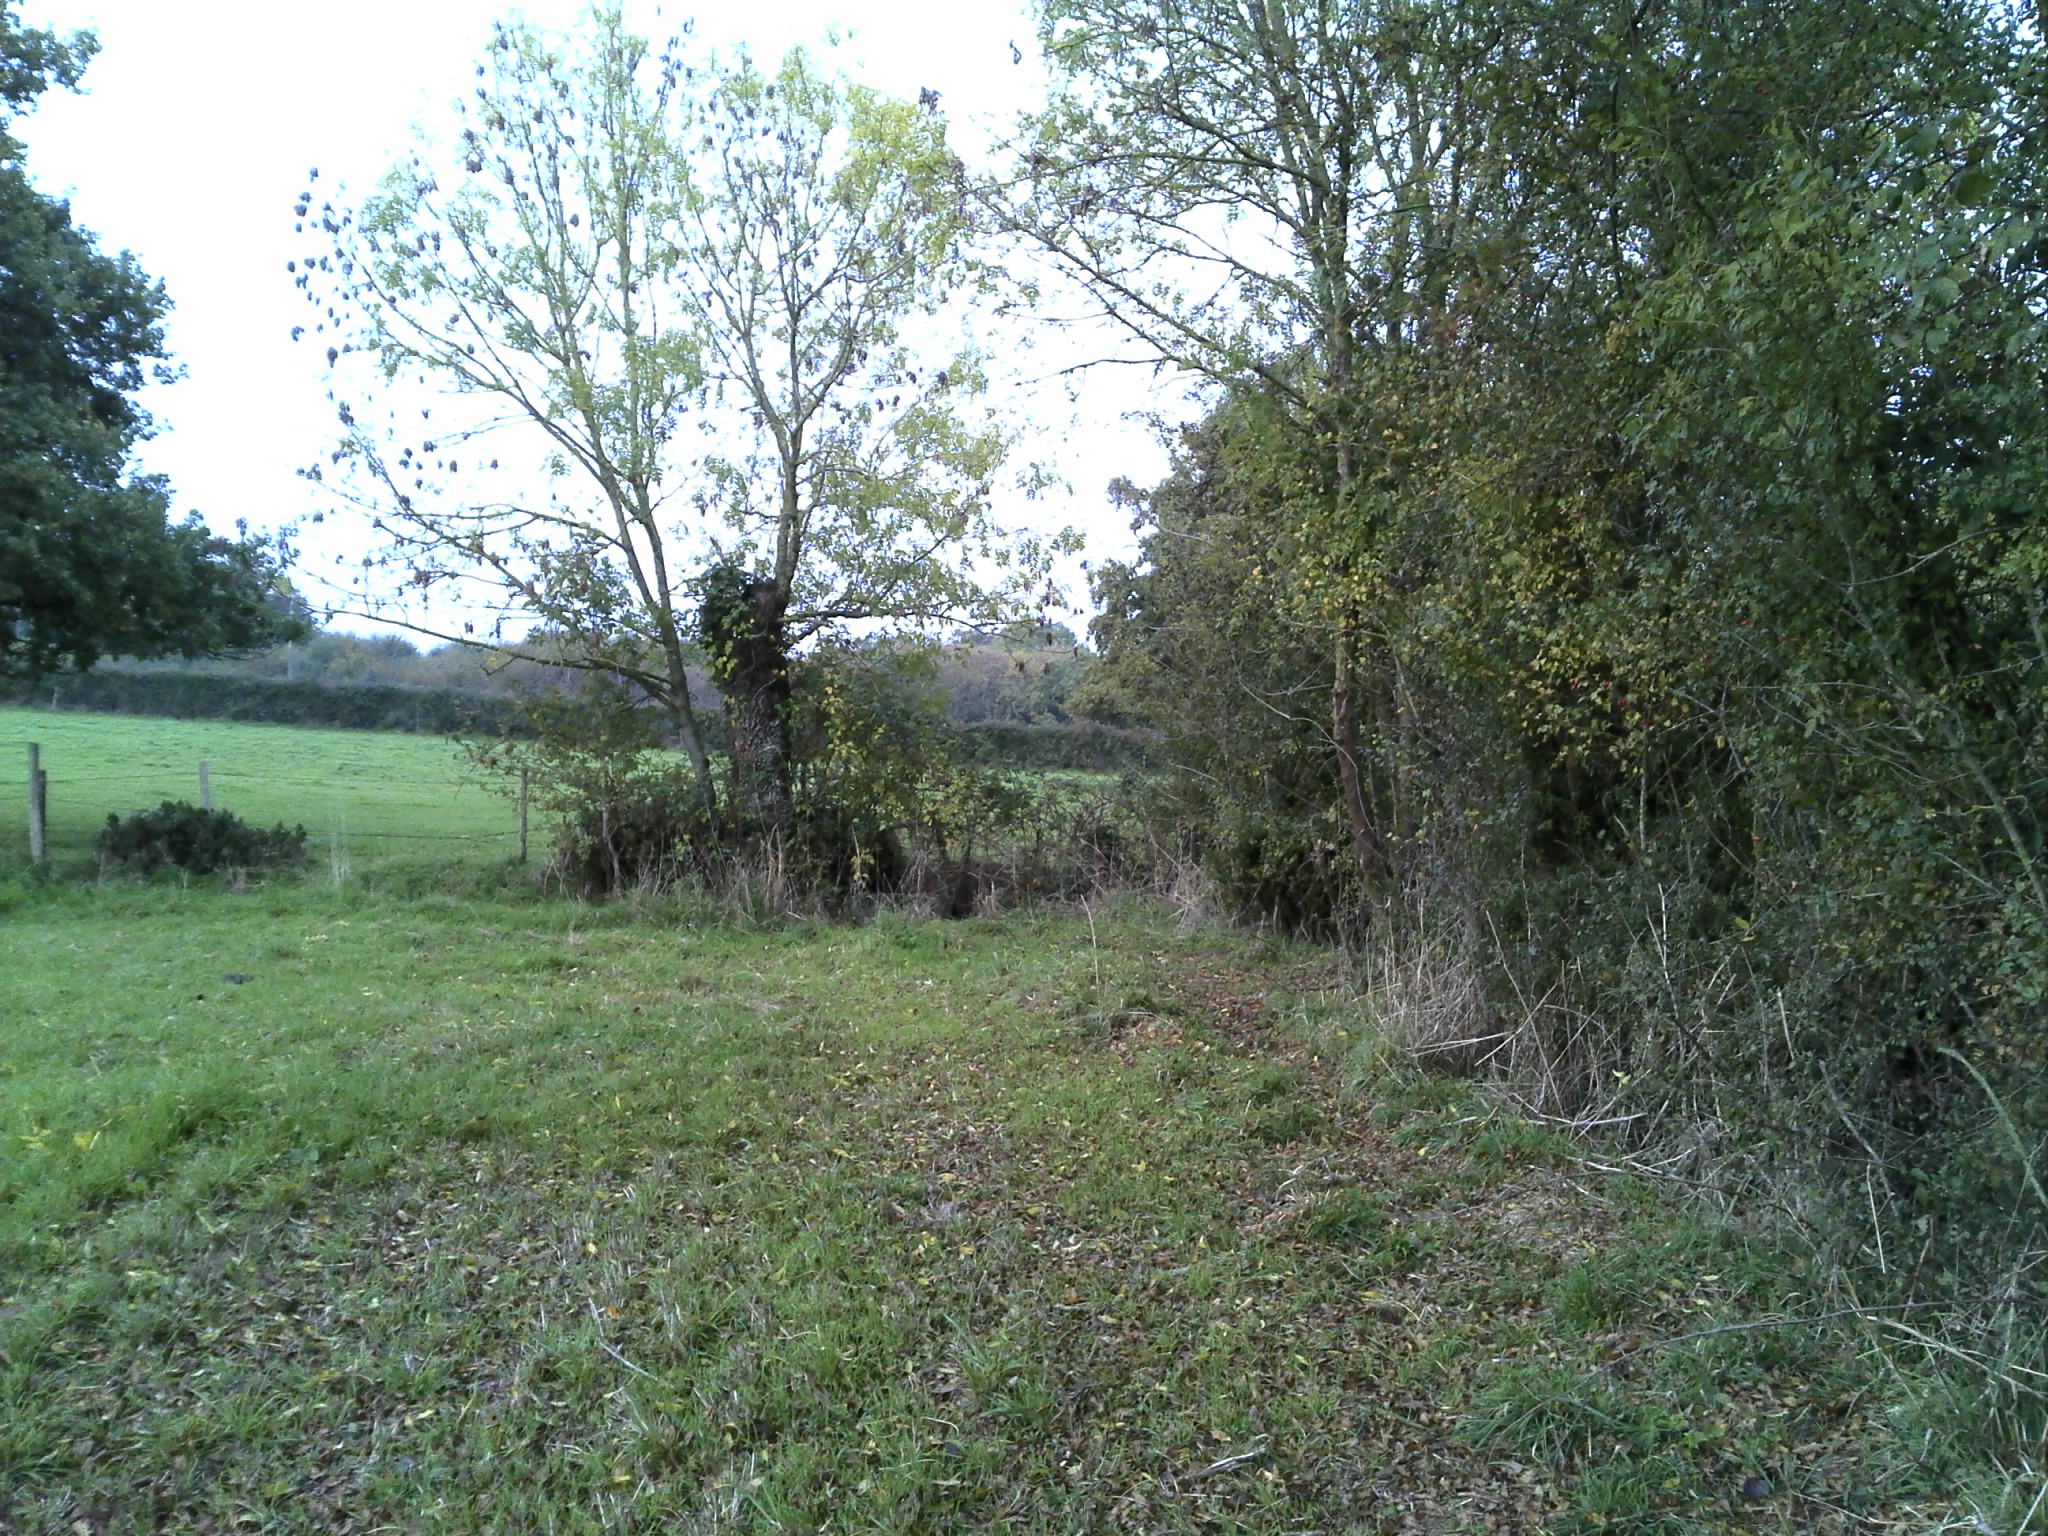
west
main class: Cropland
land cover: Temporary grasslands
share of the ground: > 75 %
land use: Agriculture (excluding fallow land and kitchen gardens)
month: October
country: FR
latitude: 47.2928
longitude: -0.9711
